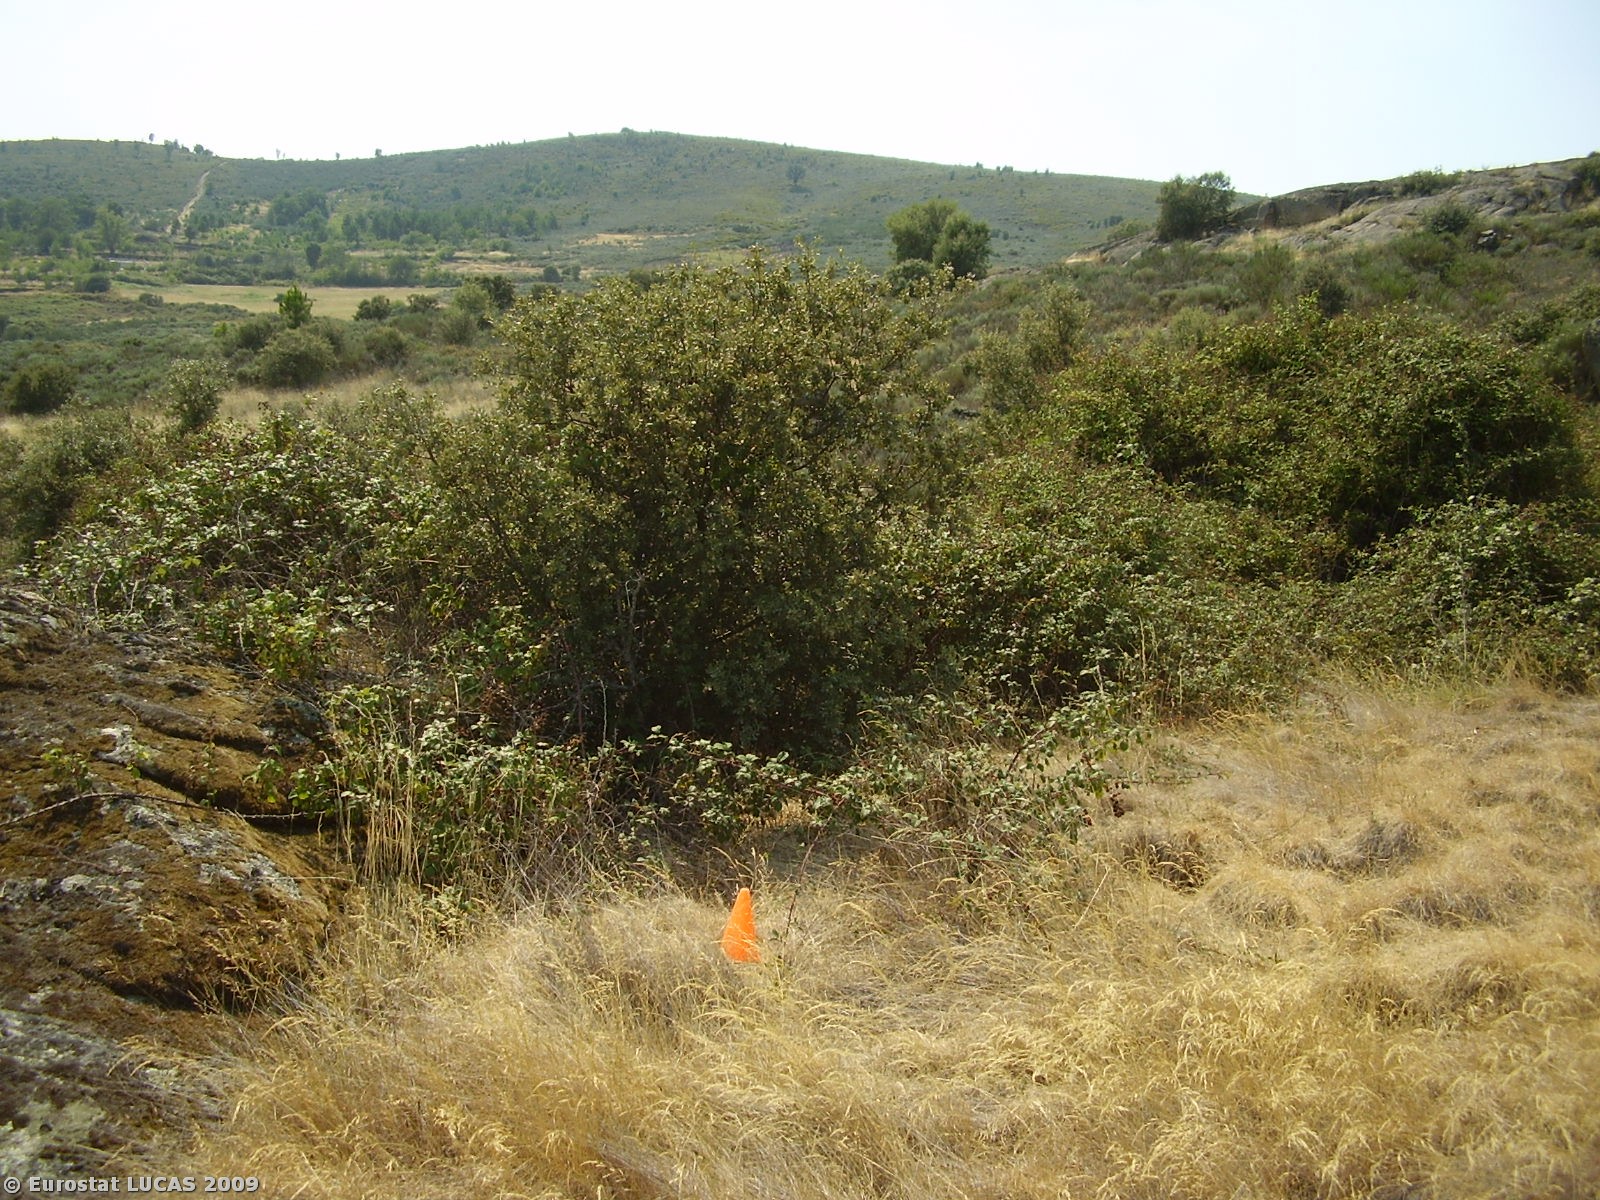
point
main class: Grassland
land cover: Grassland with sparse tree/shrub cover
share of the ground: > 75 %
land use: Fallow land
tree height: > 5 m
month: August
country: PT
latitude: 41.1689
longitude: -6.7789
